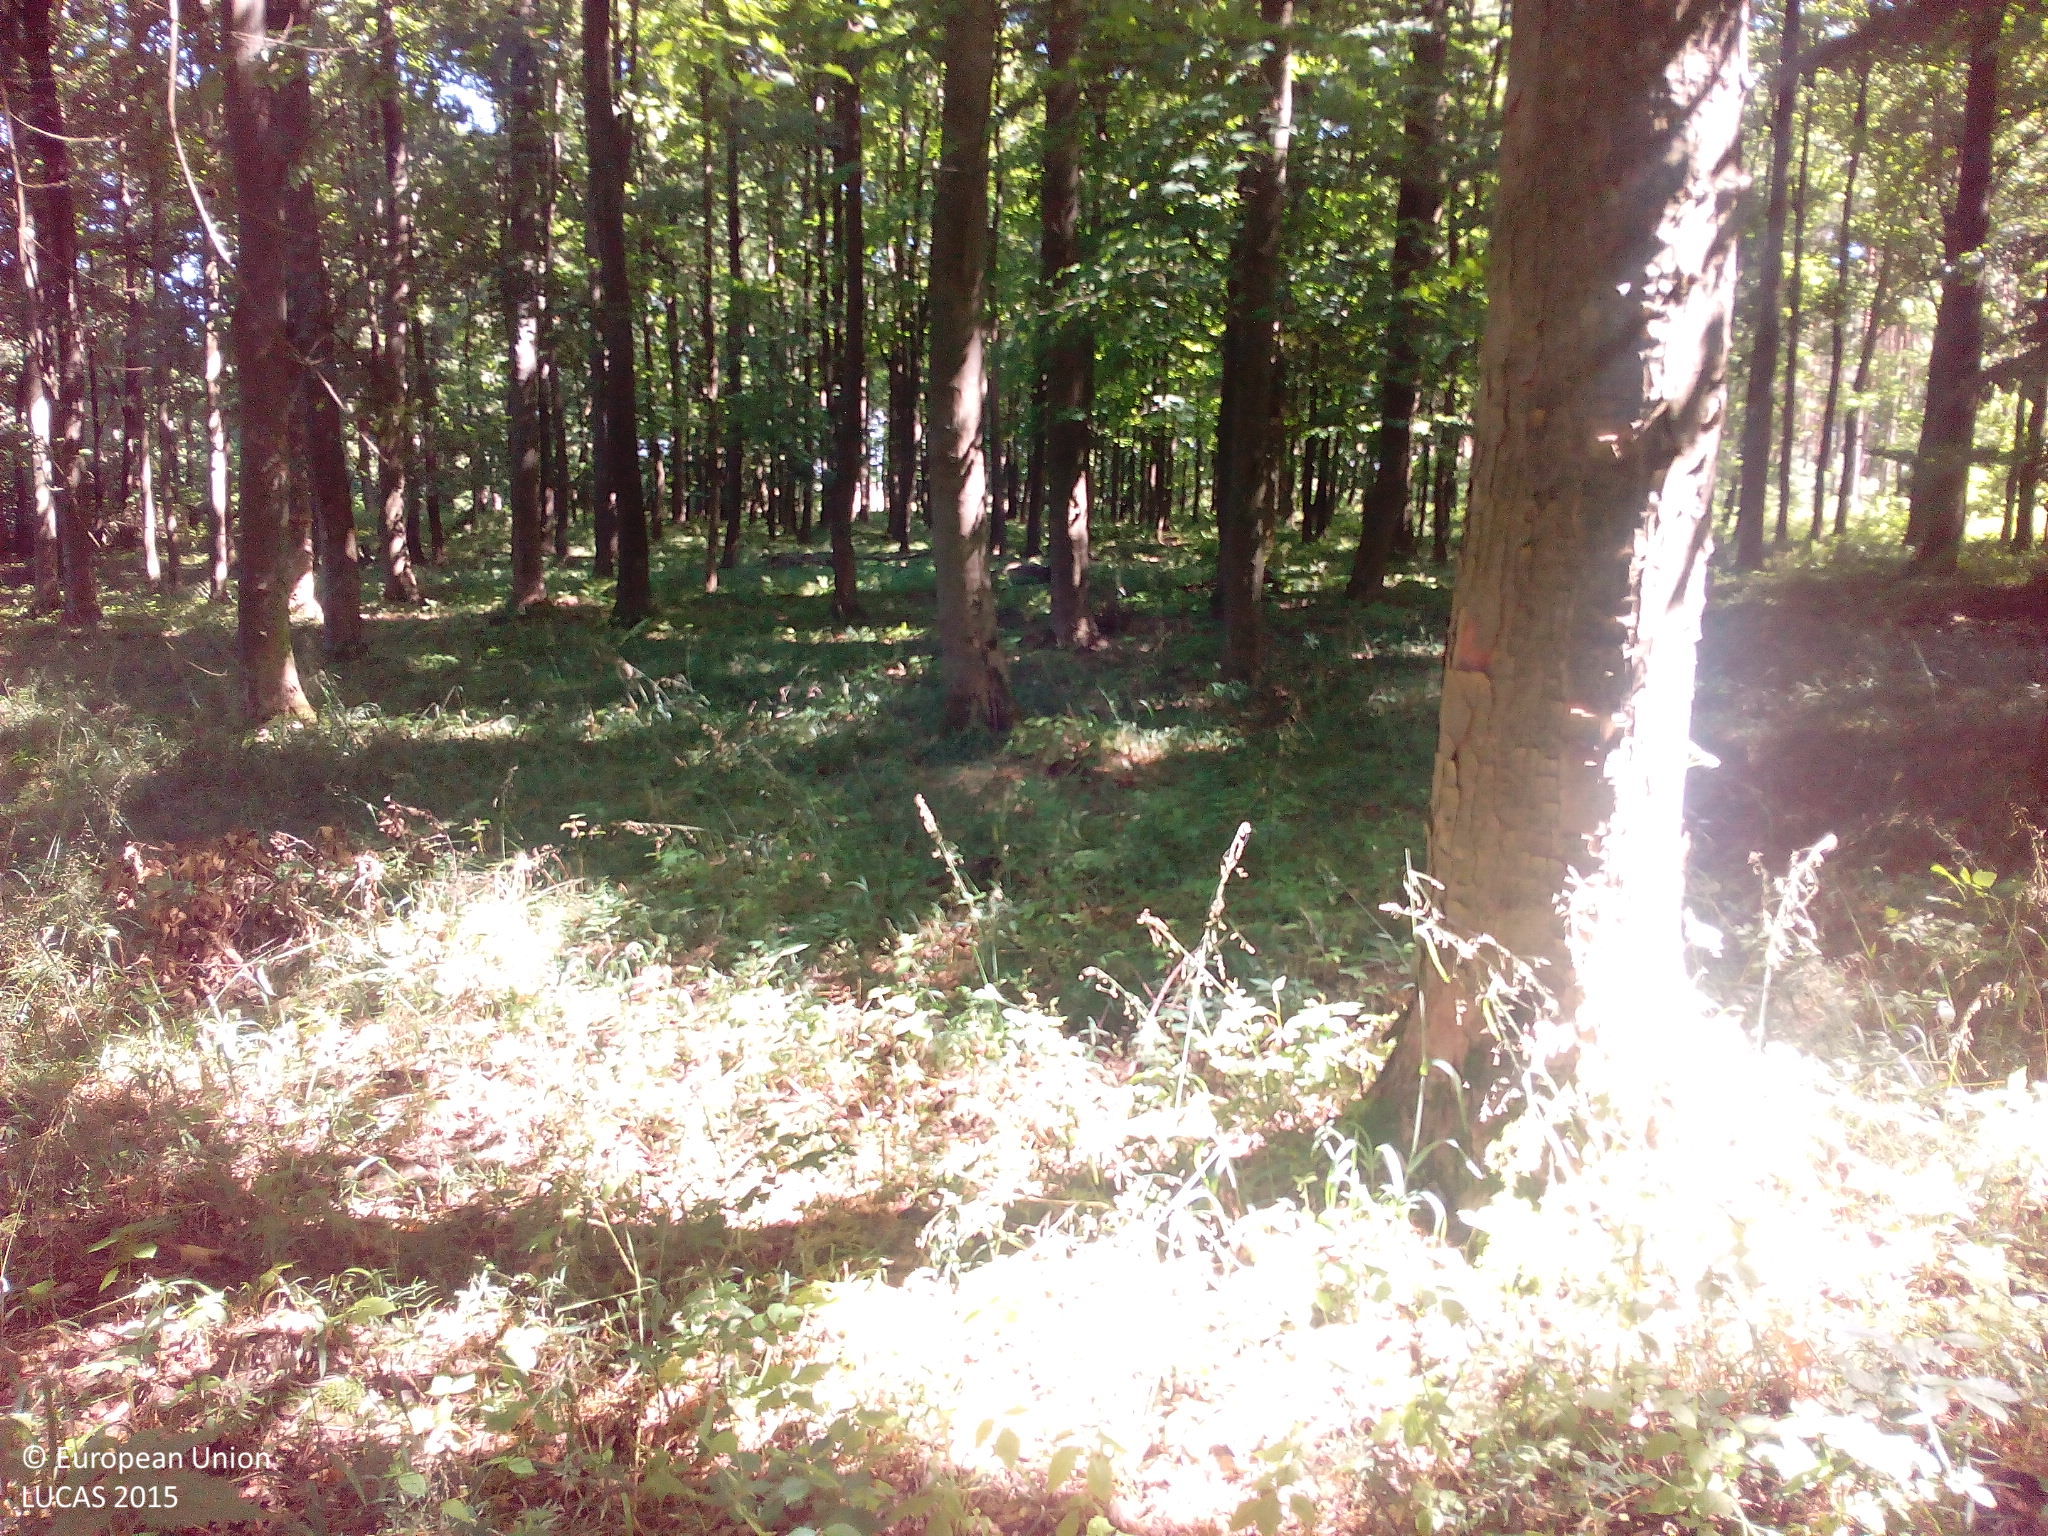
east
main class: Woodland
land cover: Broadleaved woodland
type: mesophytic deciduous forest
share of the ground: > 75 %
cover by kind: broadleaved forest trees 90 %, herbaceous plants 10 %
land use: Forestry
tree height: > 5 m
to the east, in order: Broadleaved woodland; Fences; Grassland without tree/shrub cover
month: August
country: DE
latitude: 53.4490
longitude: 12.4537
